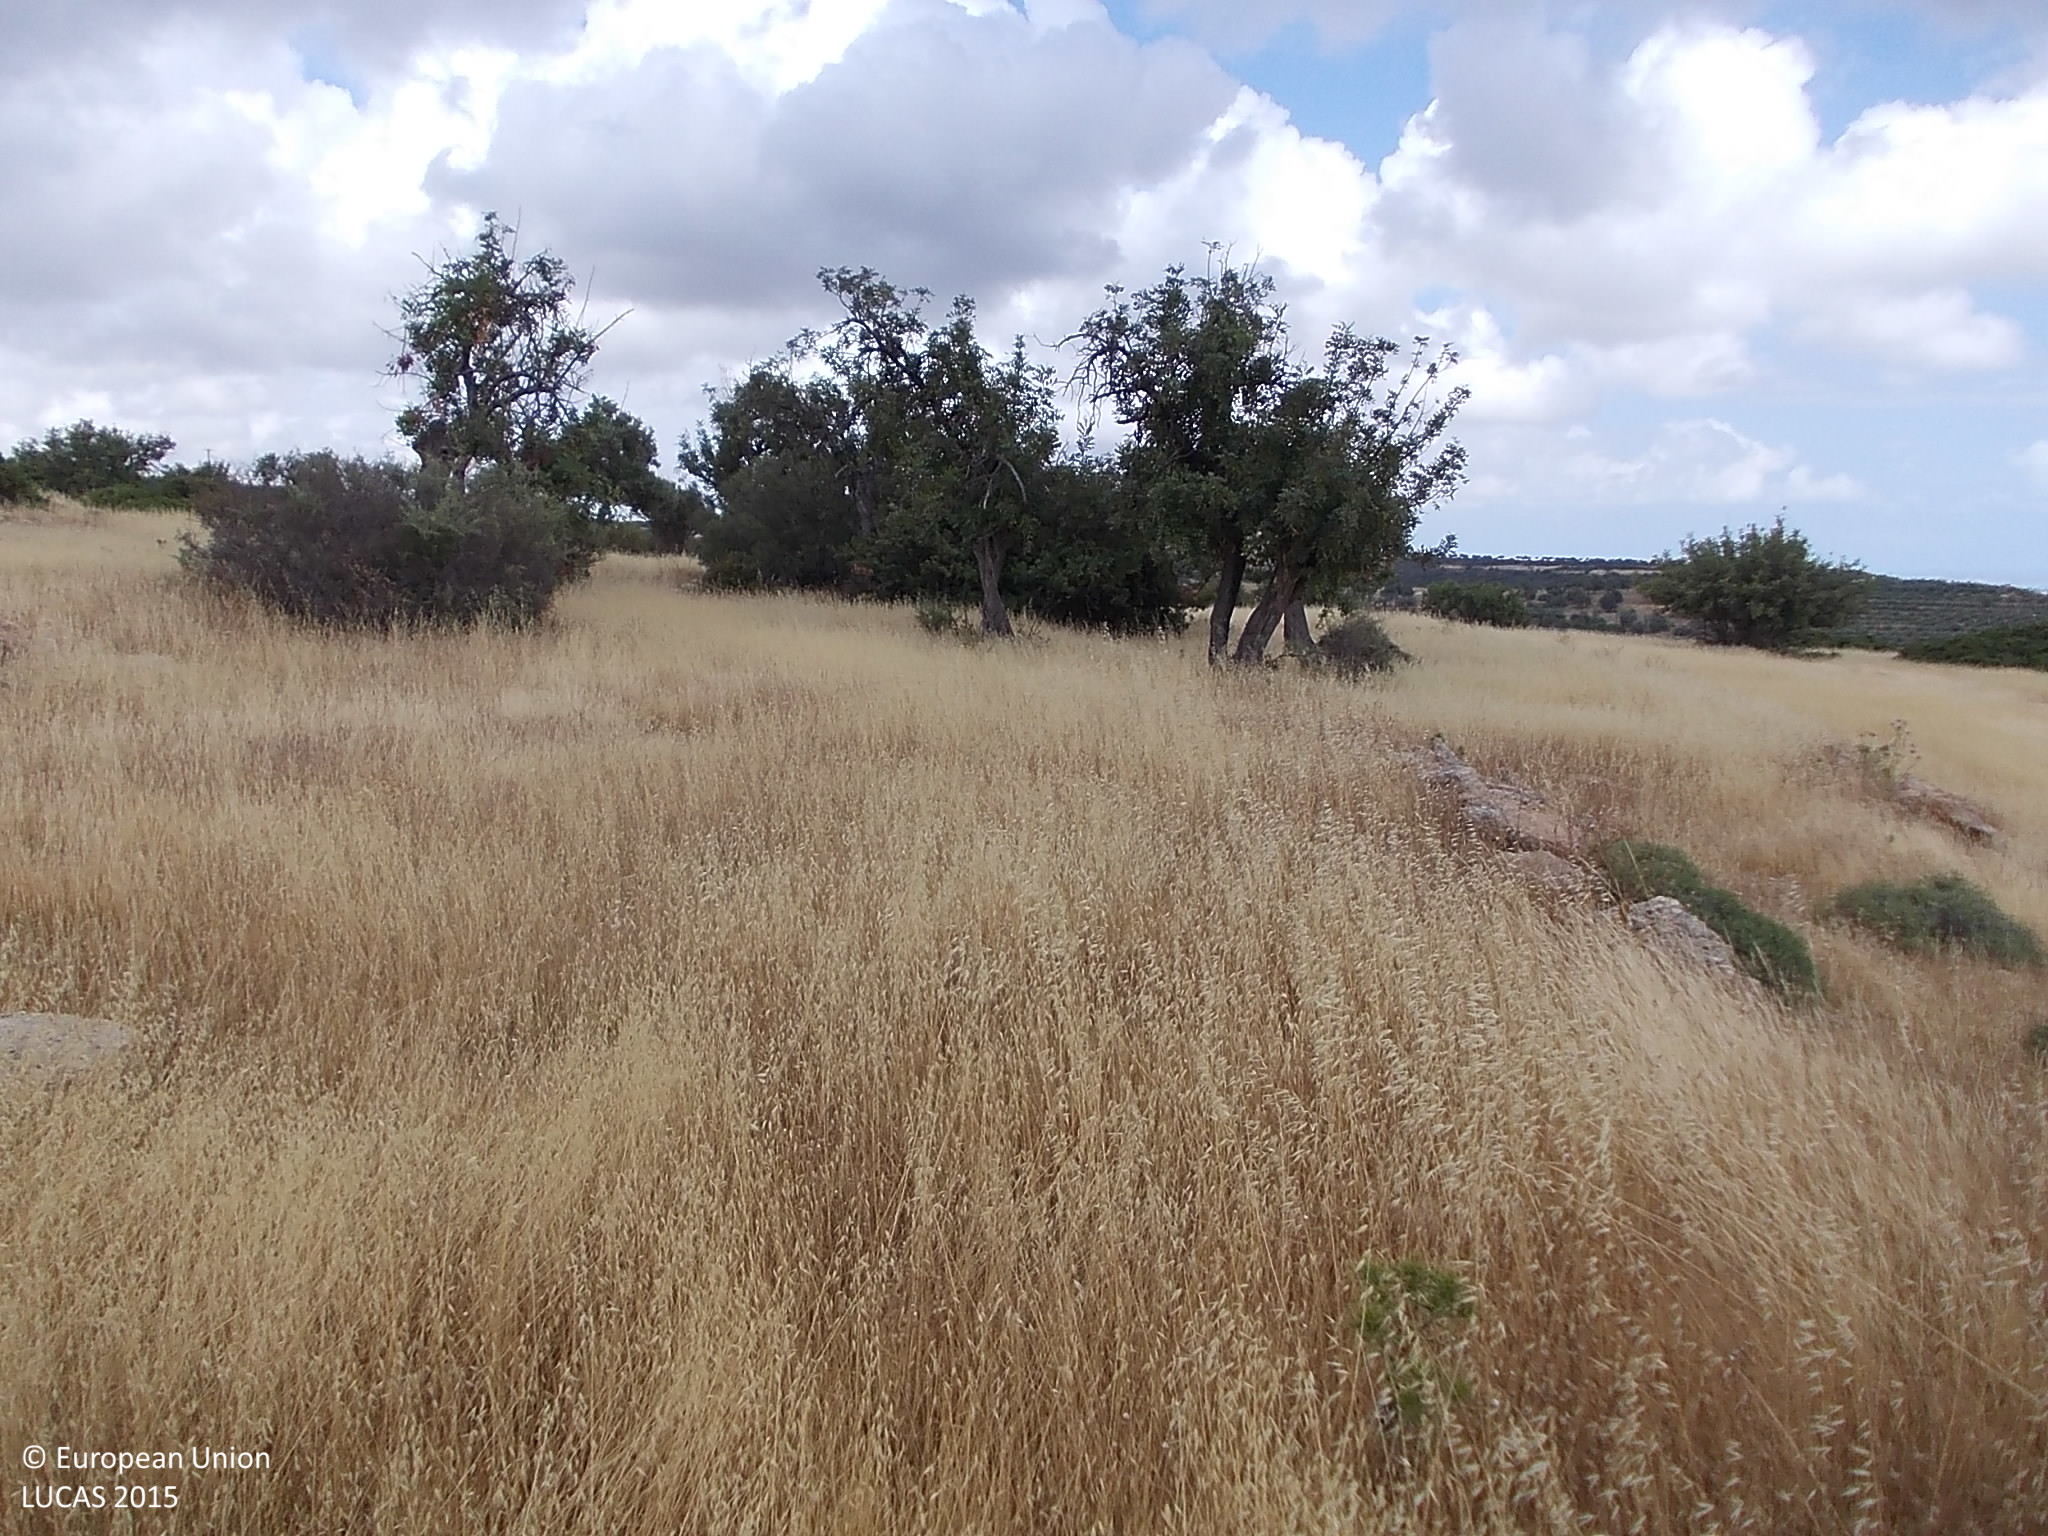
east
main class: Grassland
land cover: Grassland with sparse tree/shrub cover
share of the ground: > 75 %
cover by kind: herbaceous plants 85 %, coniferous forest trees 5 %, shrubs 5 %, consolidated bare surface 5 %
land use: Semi-natural and natural areas not in use
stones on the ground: 10 - 25 %
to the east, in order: Grassland with sparse tree/shrub cover; Broadleaved woodland; Tracks; Grassland with sparse tree/shrub cover; Fences; Shrubland without tree cover; Shrubland with sparse tree cover; Pine dominated coniferous woodland; Grassland without tree/shrub cover; Shrubland with sparse tree cover
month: May
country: CY
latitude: 34.7211
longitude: 32.7707
